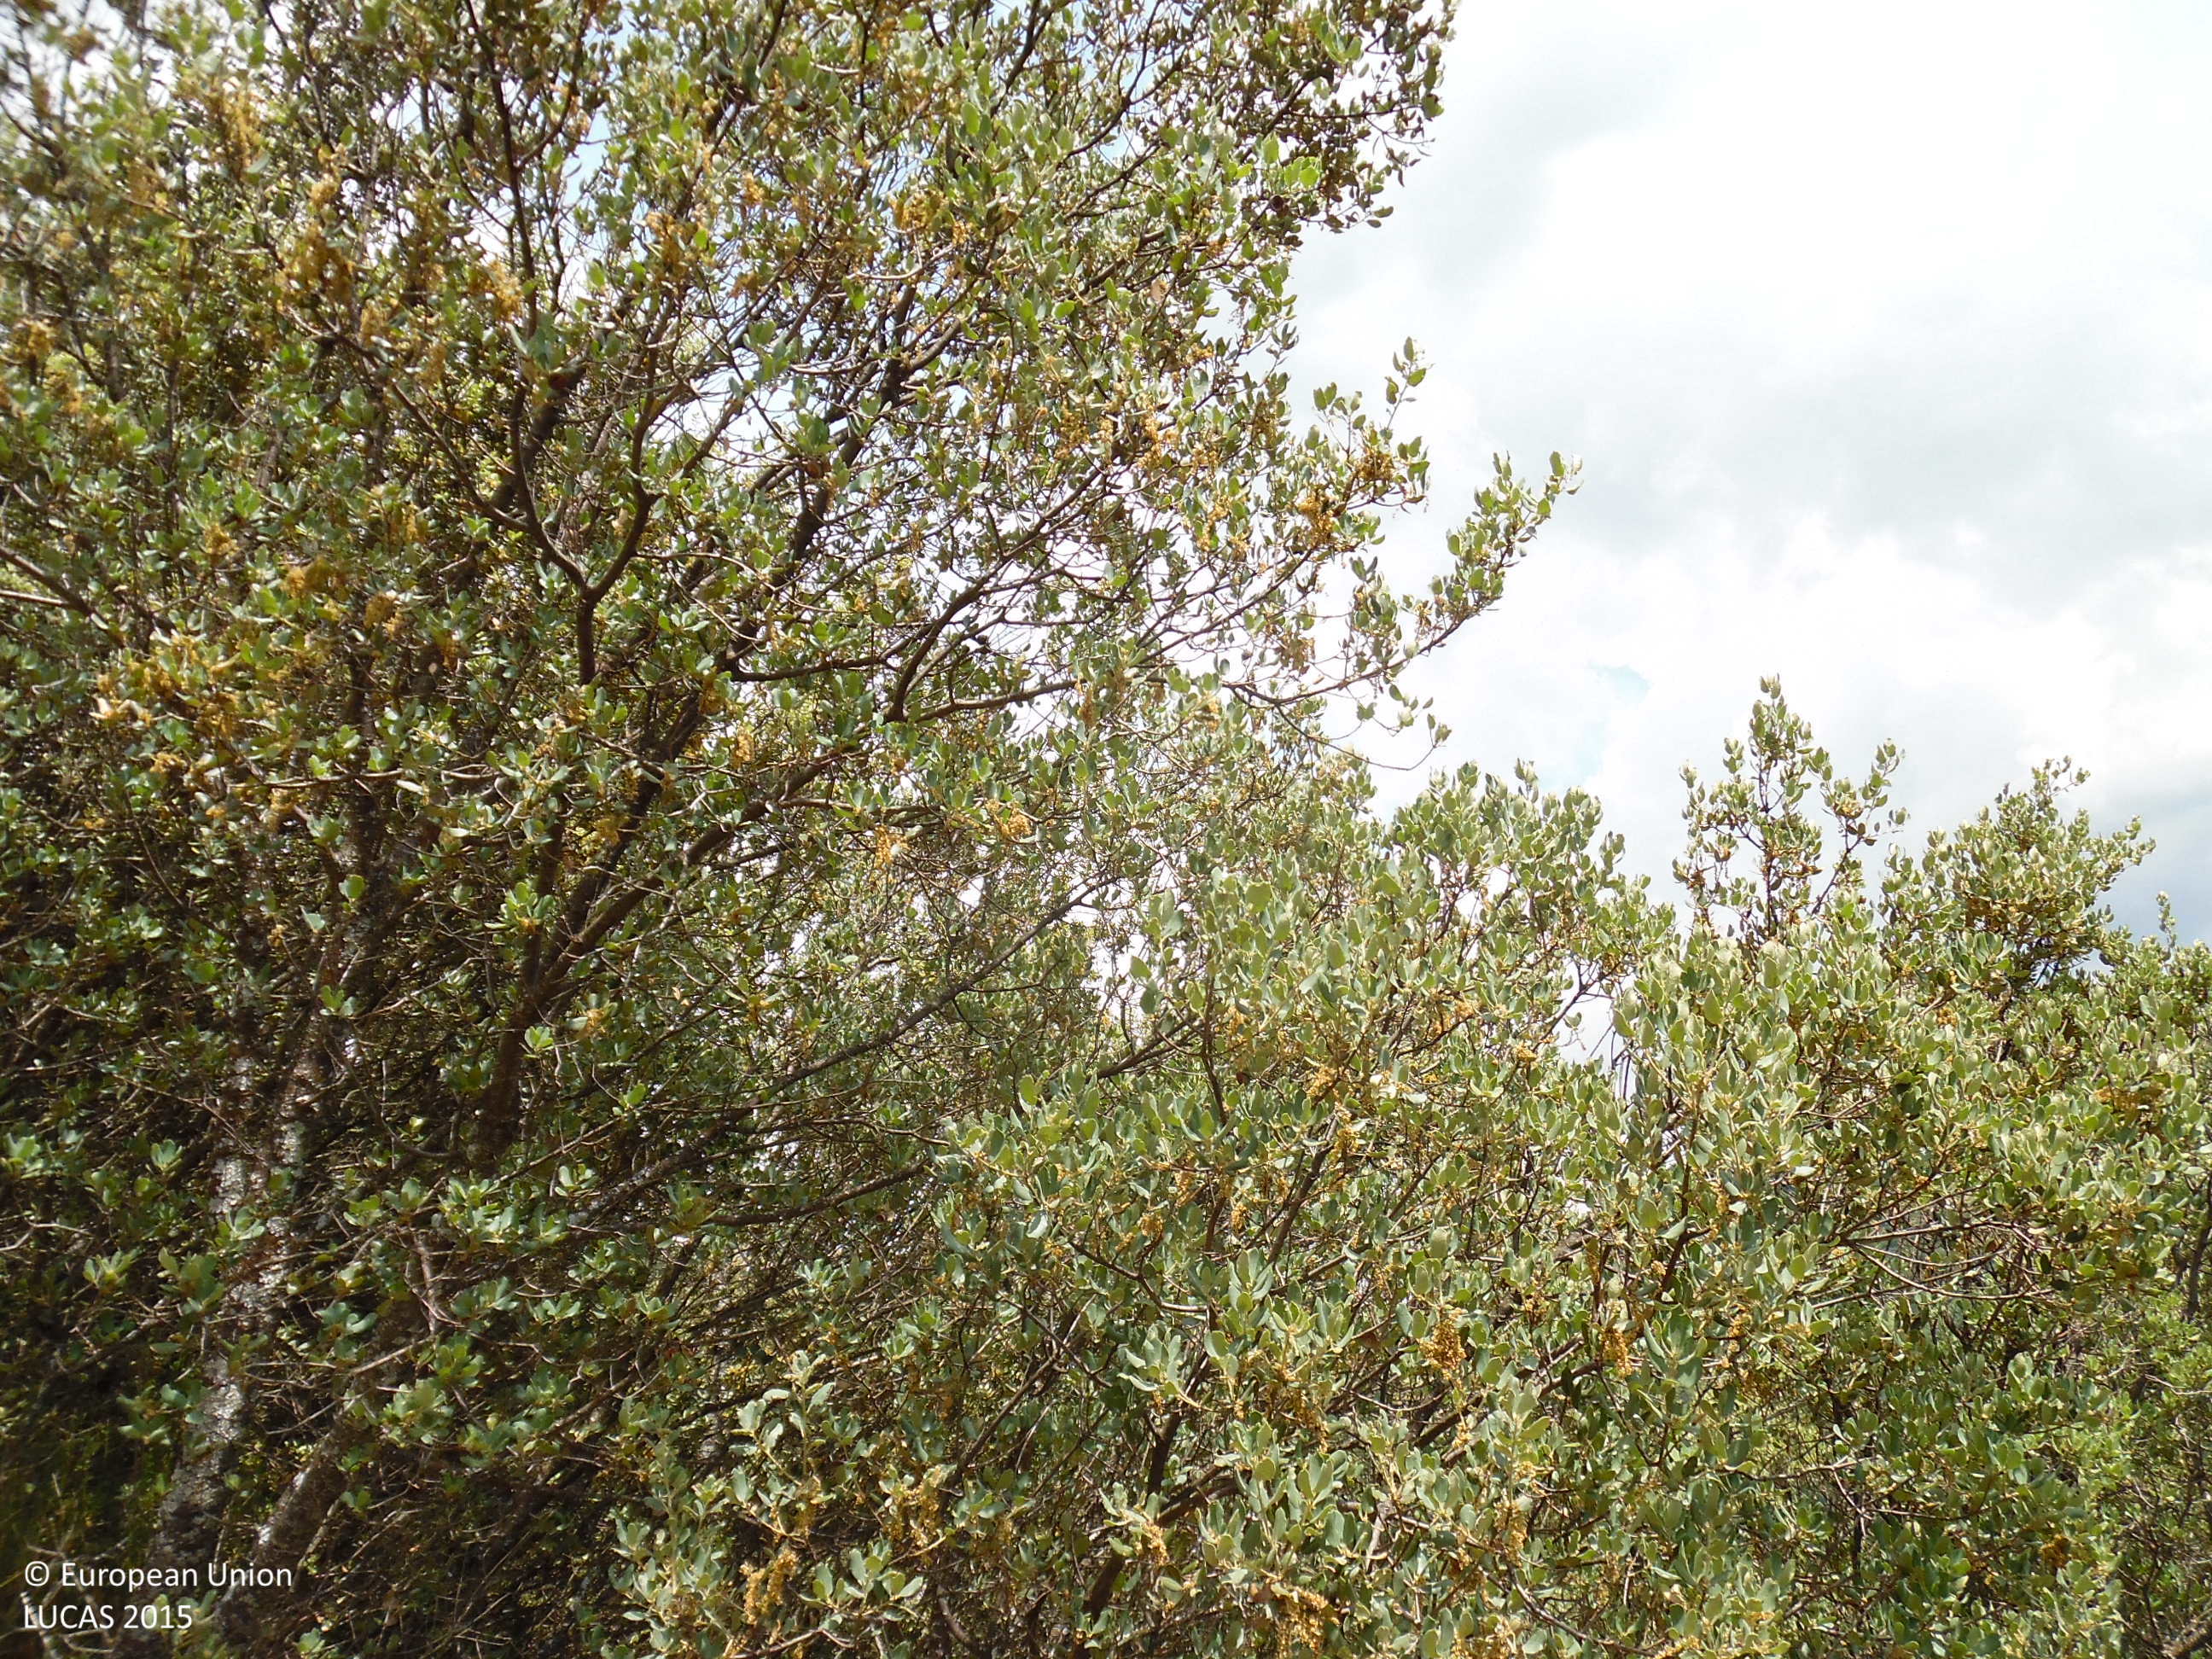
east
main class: Woodland
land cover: Broadleaved woodland
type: broadleaved evergreen forest
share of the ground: > 75 %
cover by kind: broadleaved forest trees 95 %, shrubs 5 %
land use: Forestry
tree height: > 5 m
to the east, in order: Broadleaved woodland; Shrubland with sparse tree cover; Grassland with sparse tree/shrub cover; Shrubland with sparse tree cover
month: June
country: ES
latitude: 42.2639
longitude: -6.6156
